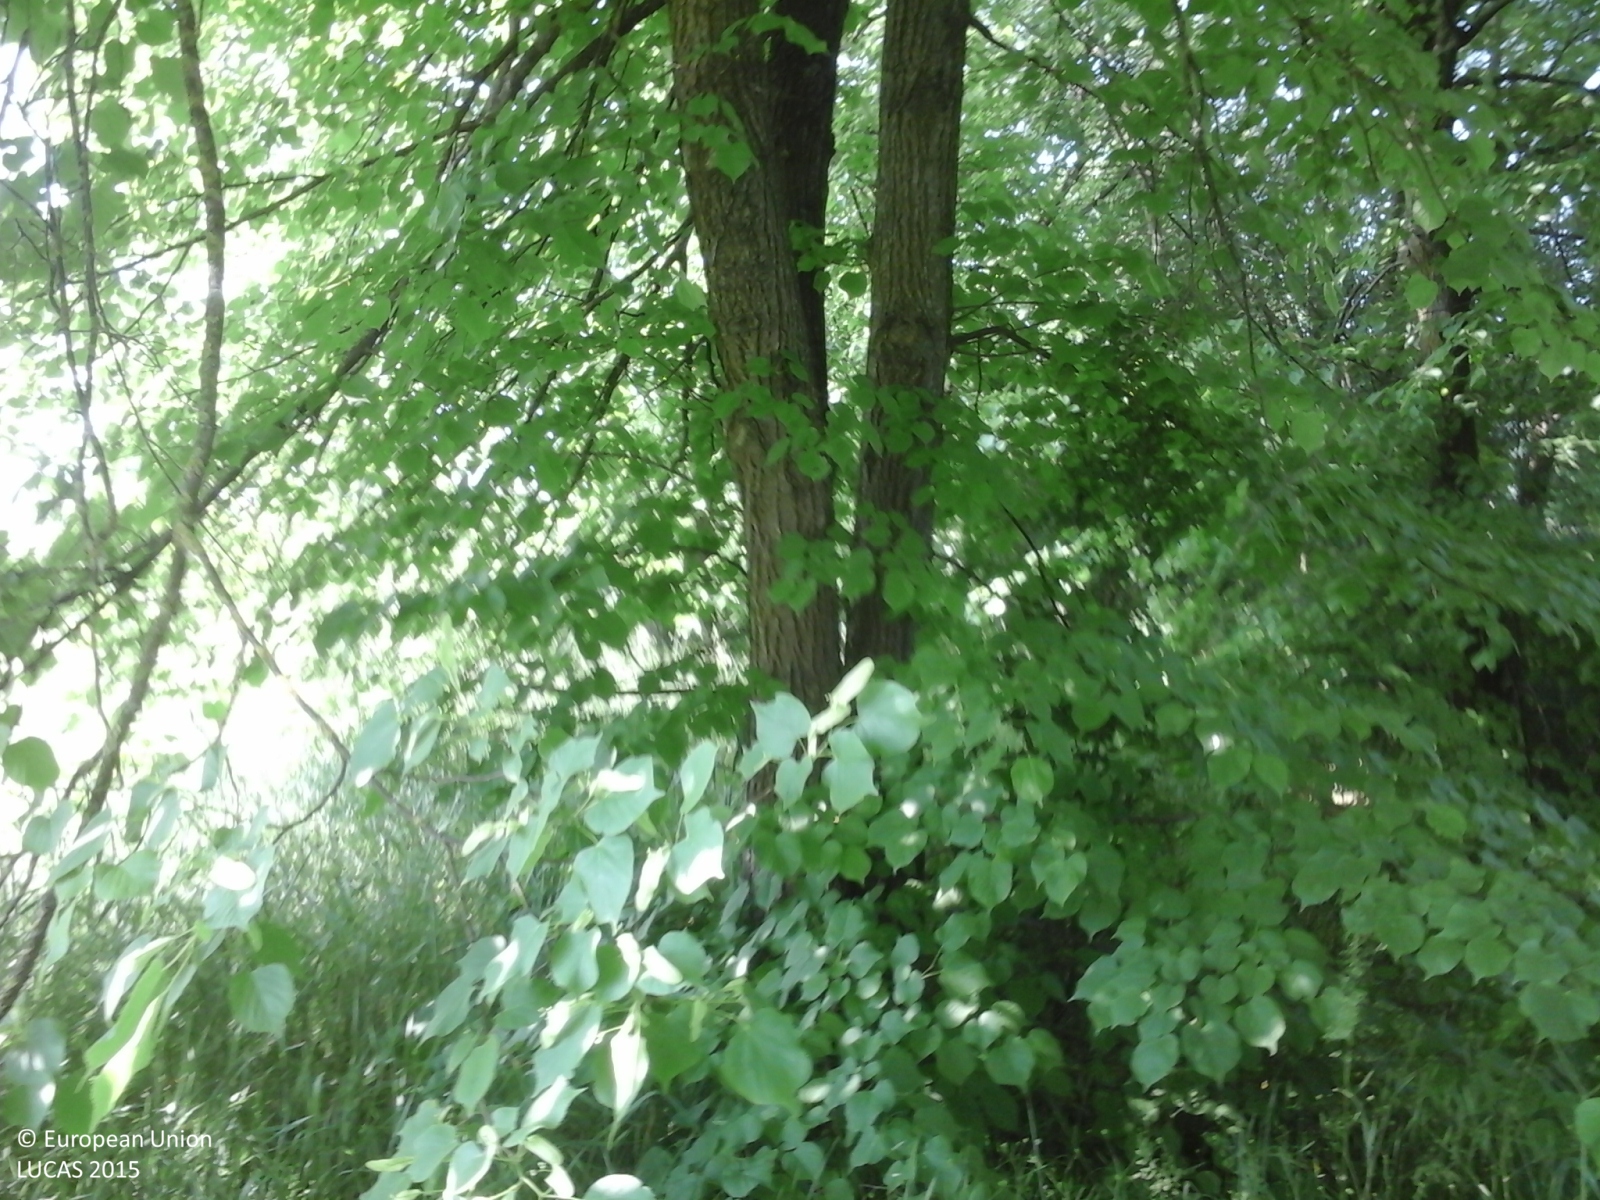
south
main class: Woodland
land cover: Broadleaved woodland
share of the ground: > 75 %
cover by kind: broadleaved forest trees 85 %, herbaceous plants 15 %
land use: Amenities, museums, leisure
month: May
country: IT
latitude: 44.5625
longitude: 10.9674
